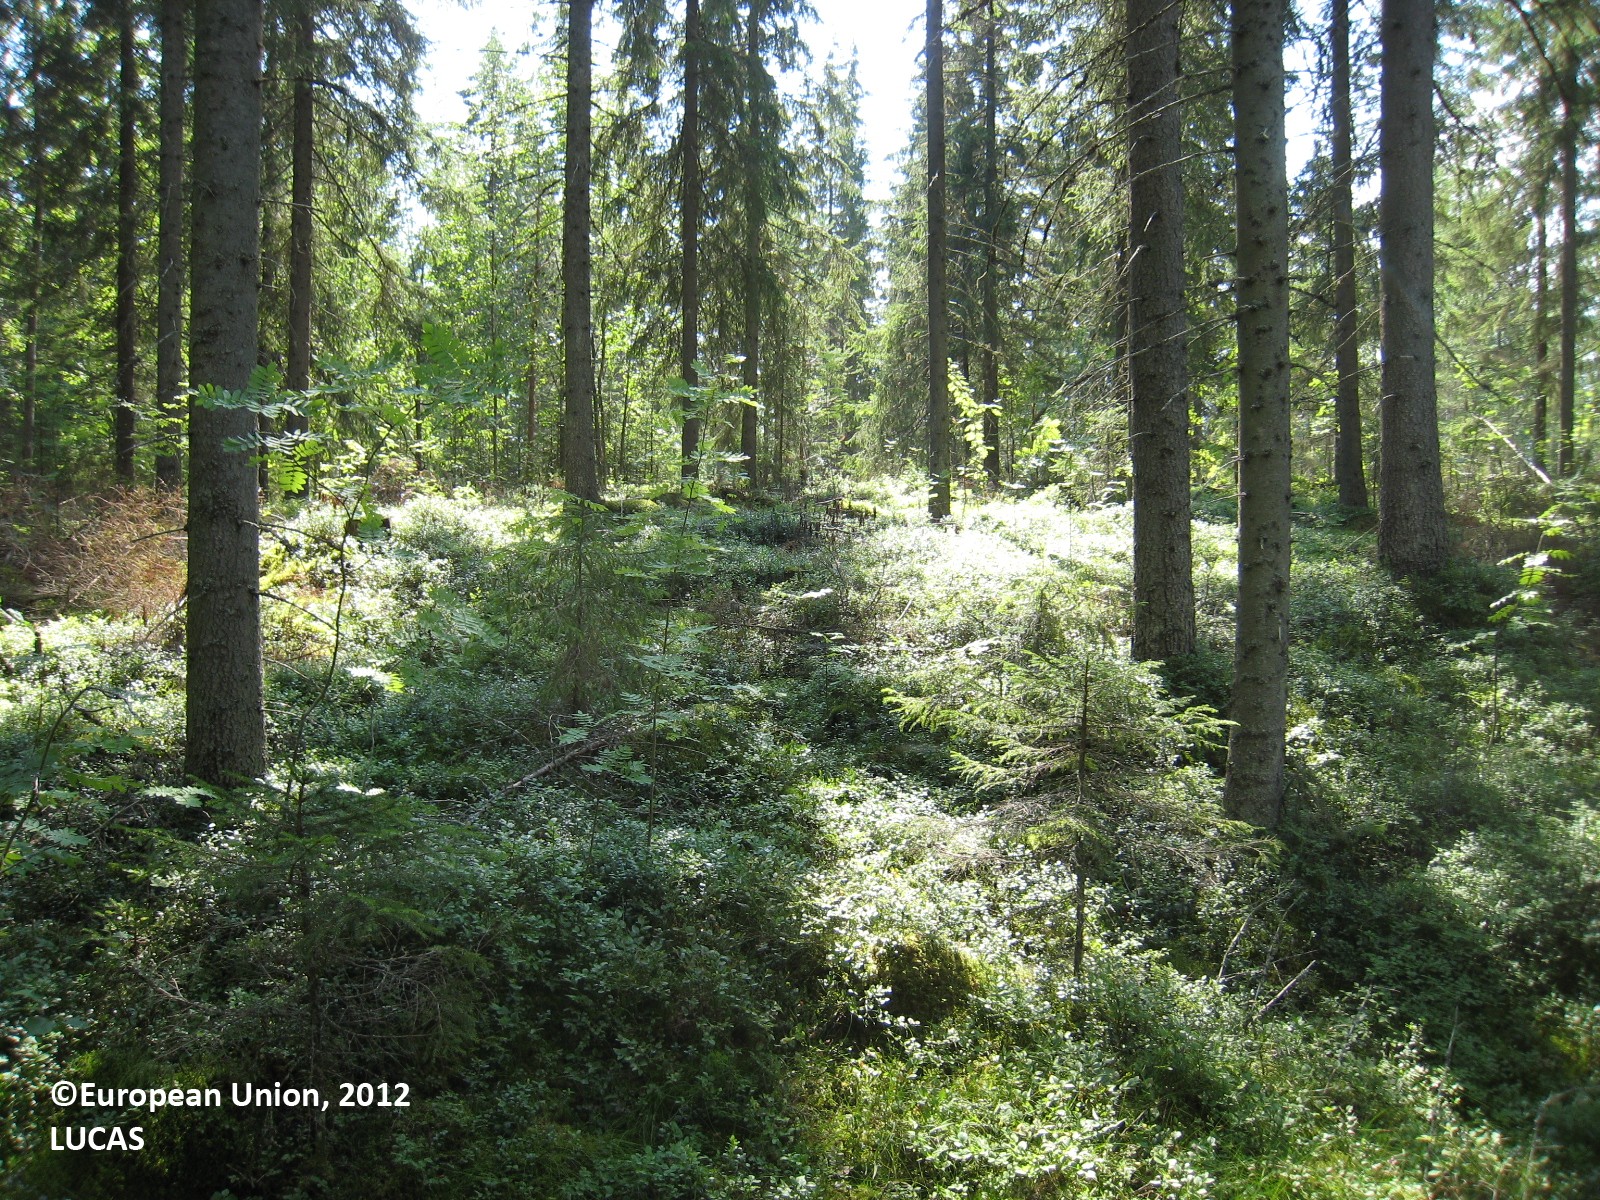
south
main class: Woodland
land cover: Spruce dominated coniferous woodland
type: boreal forest
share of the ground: 50 - 75 %
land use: Forestry
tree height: > 5 m
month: July
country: FI
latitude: 61.7901
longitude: 26.1205
